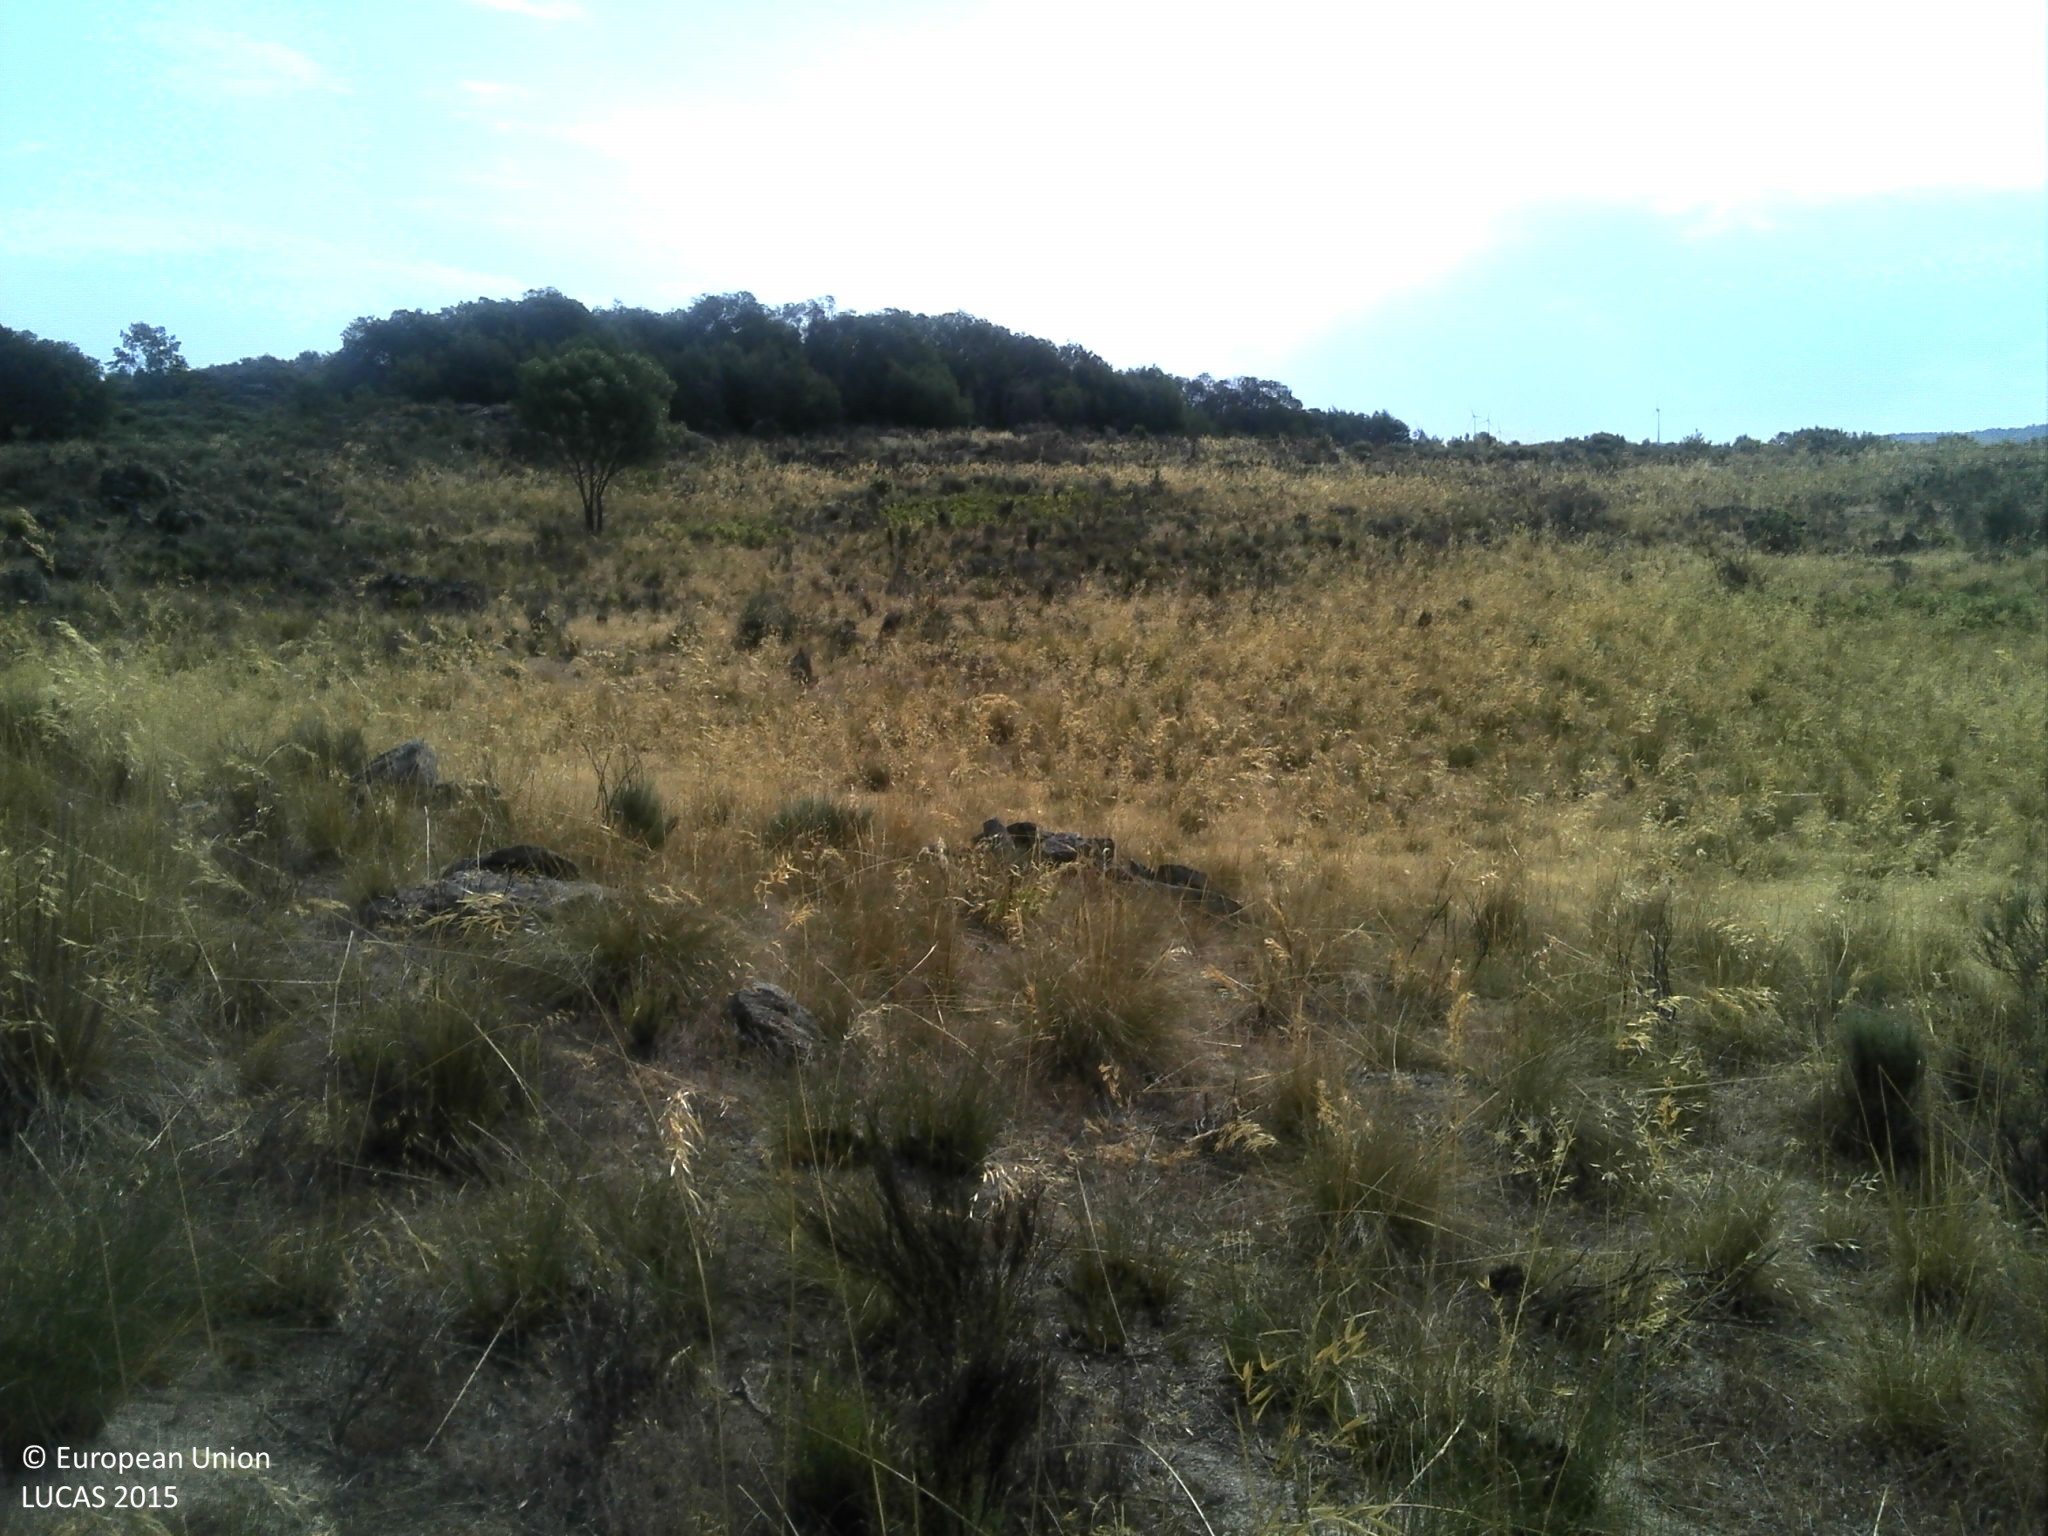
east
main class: Grassland
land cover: Grassland without tree/shrub cover
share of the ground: 50 - 75 %
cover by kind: herbaceous plants 60 %, unconsolidated bare surface 40 %
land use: Agriculture (excluding fallow land and kitchen gardens)
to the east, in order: Grassland without tree/shrub cover; Rocks and stones; Shrubland without tree cover; Rocks and stones; Shrubland with sparse tree cover
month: June
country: PT
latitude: 40.3486
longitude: -7.2562
